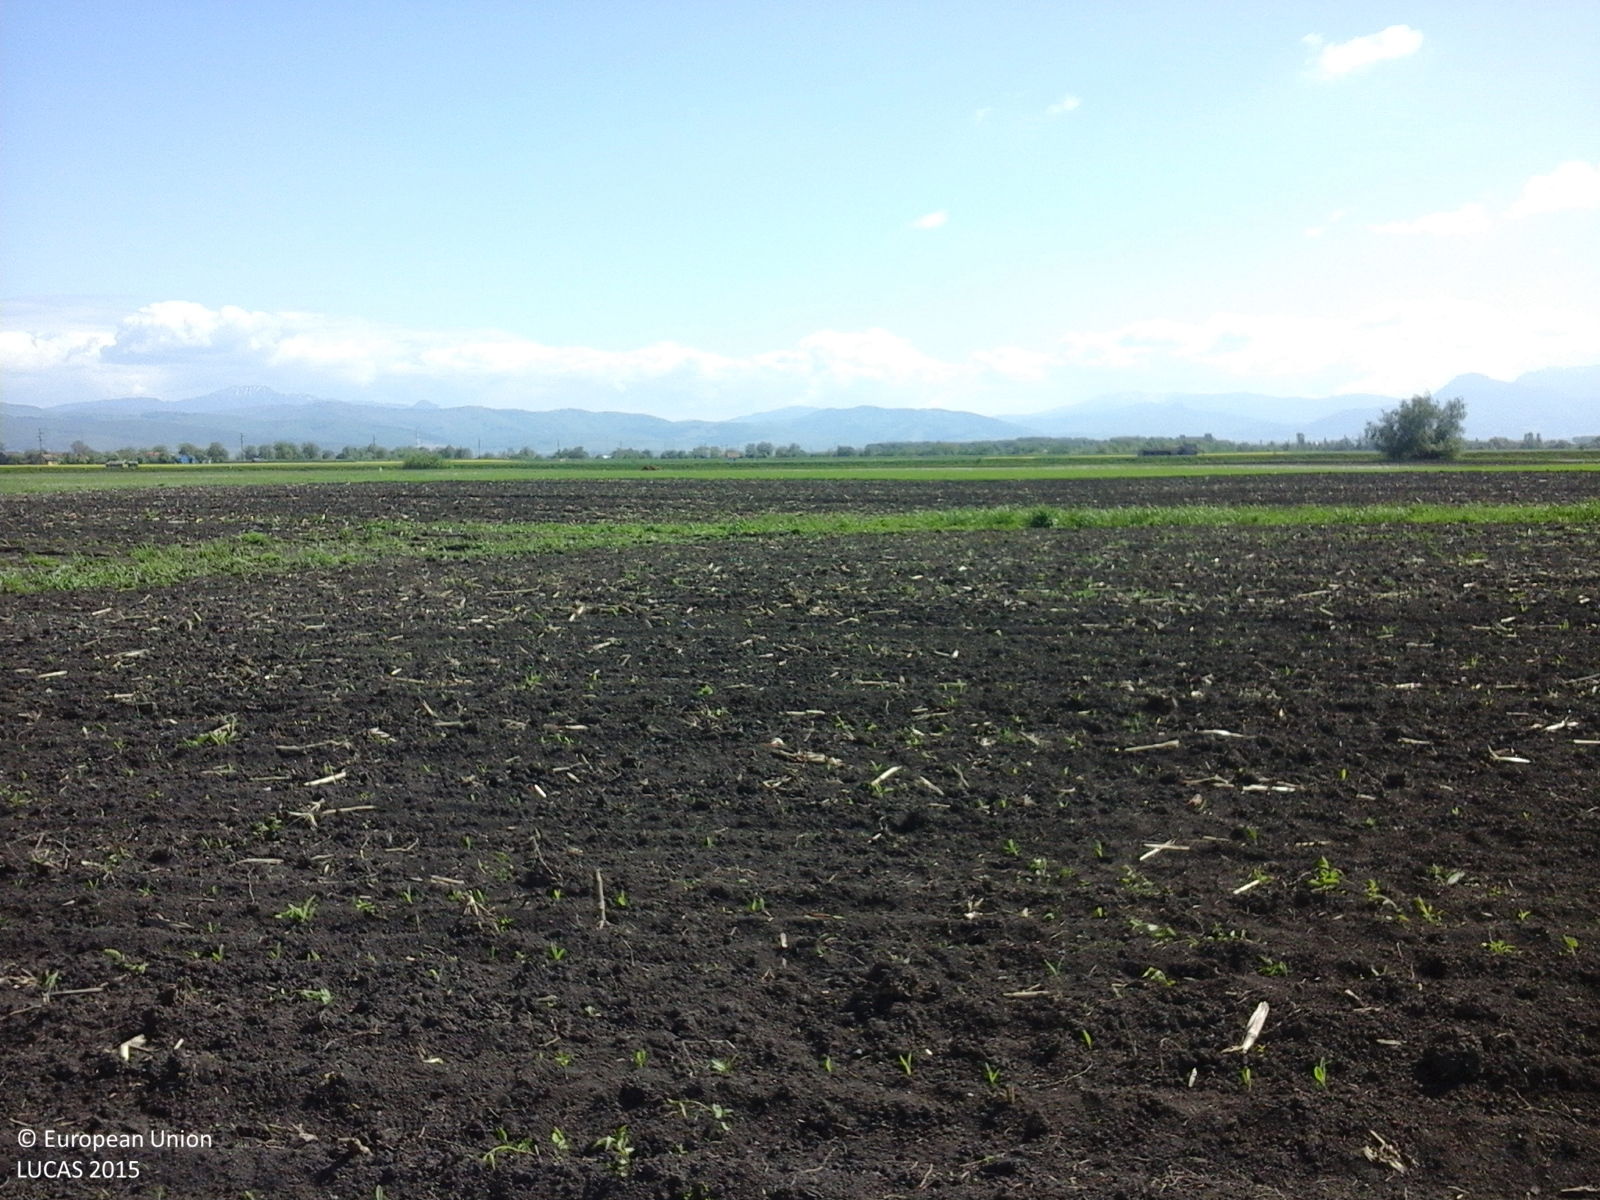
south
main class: Cropland
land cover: Maize
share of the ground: < 10 %
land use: Agriculture (excluding fallow land and kitchen gardens)
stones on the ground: < 10 %
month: May
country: RO
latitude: 45.7747
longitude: 25.7867
